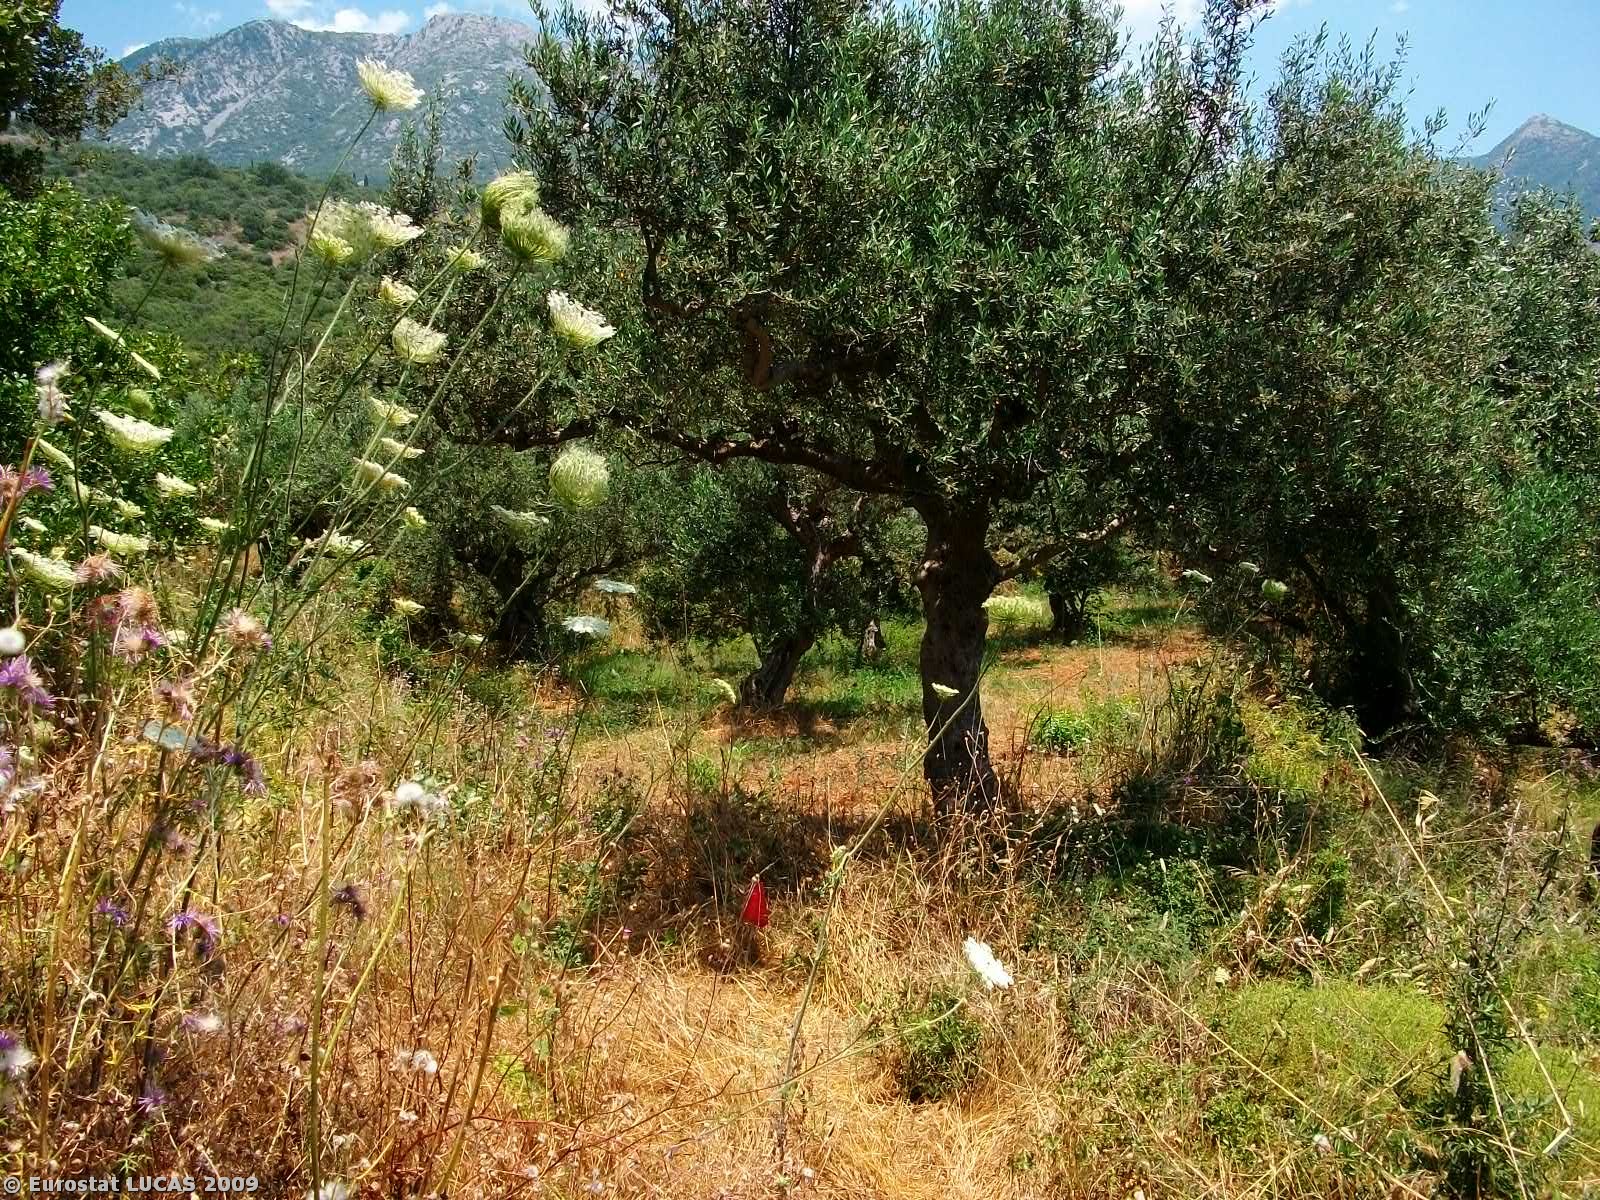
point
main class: Cropland
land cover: Olive groves
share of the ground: 50 - 75 %
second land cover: Grassland with sparse tree/shrub cover
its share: > 75 %
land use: Agriculture (excluding fallow land and kitchen gardens)
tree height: < 5 m
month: June
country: GR
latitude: 36.8570
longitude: 22.2783
